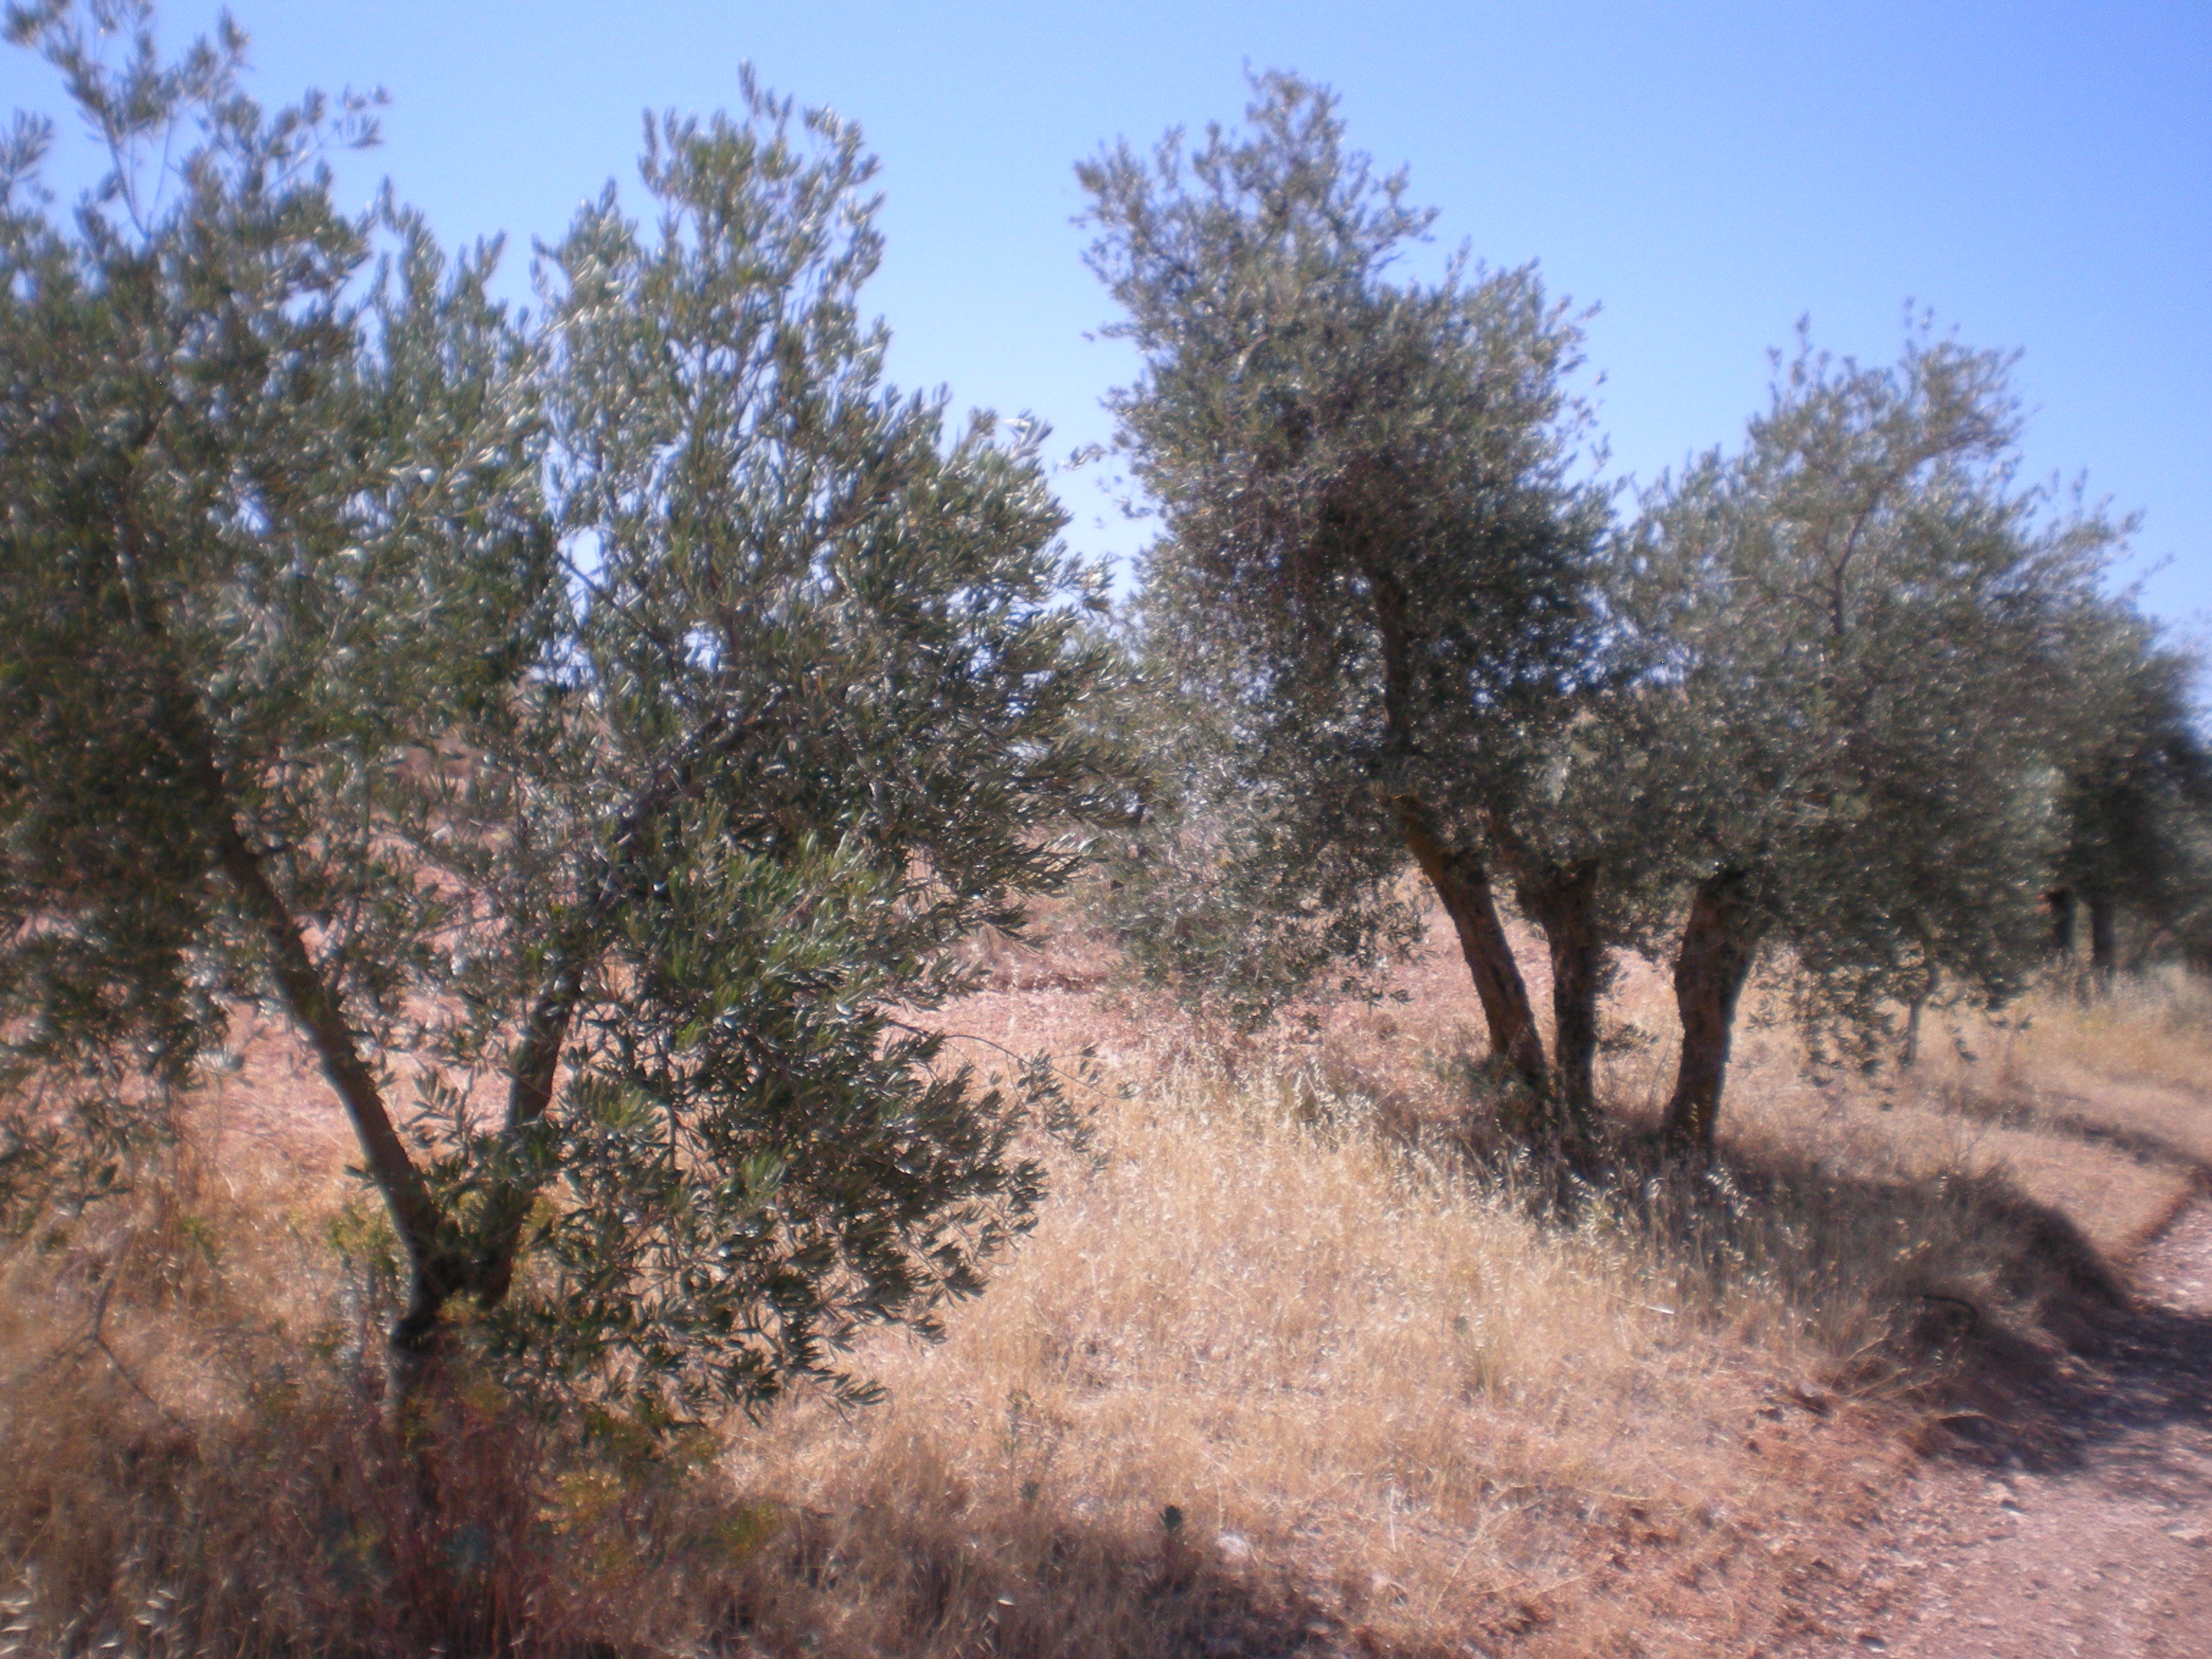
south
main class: Cropland
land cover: Olive groves
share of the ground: 25 - 50 %
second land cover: Spontaneously vegetated surfaces
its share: 10 - 25 %
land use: Agriculture (excluding fallow land and kitchen gardens)
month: July
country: ES
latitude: 39.3502
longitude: -3.3520
